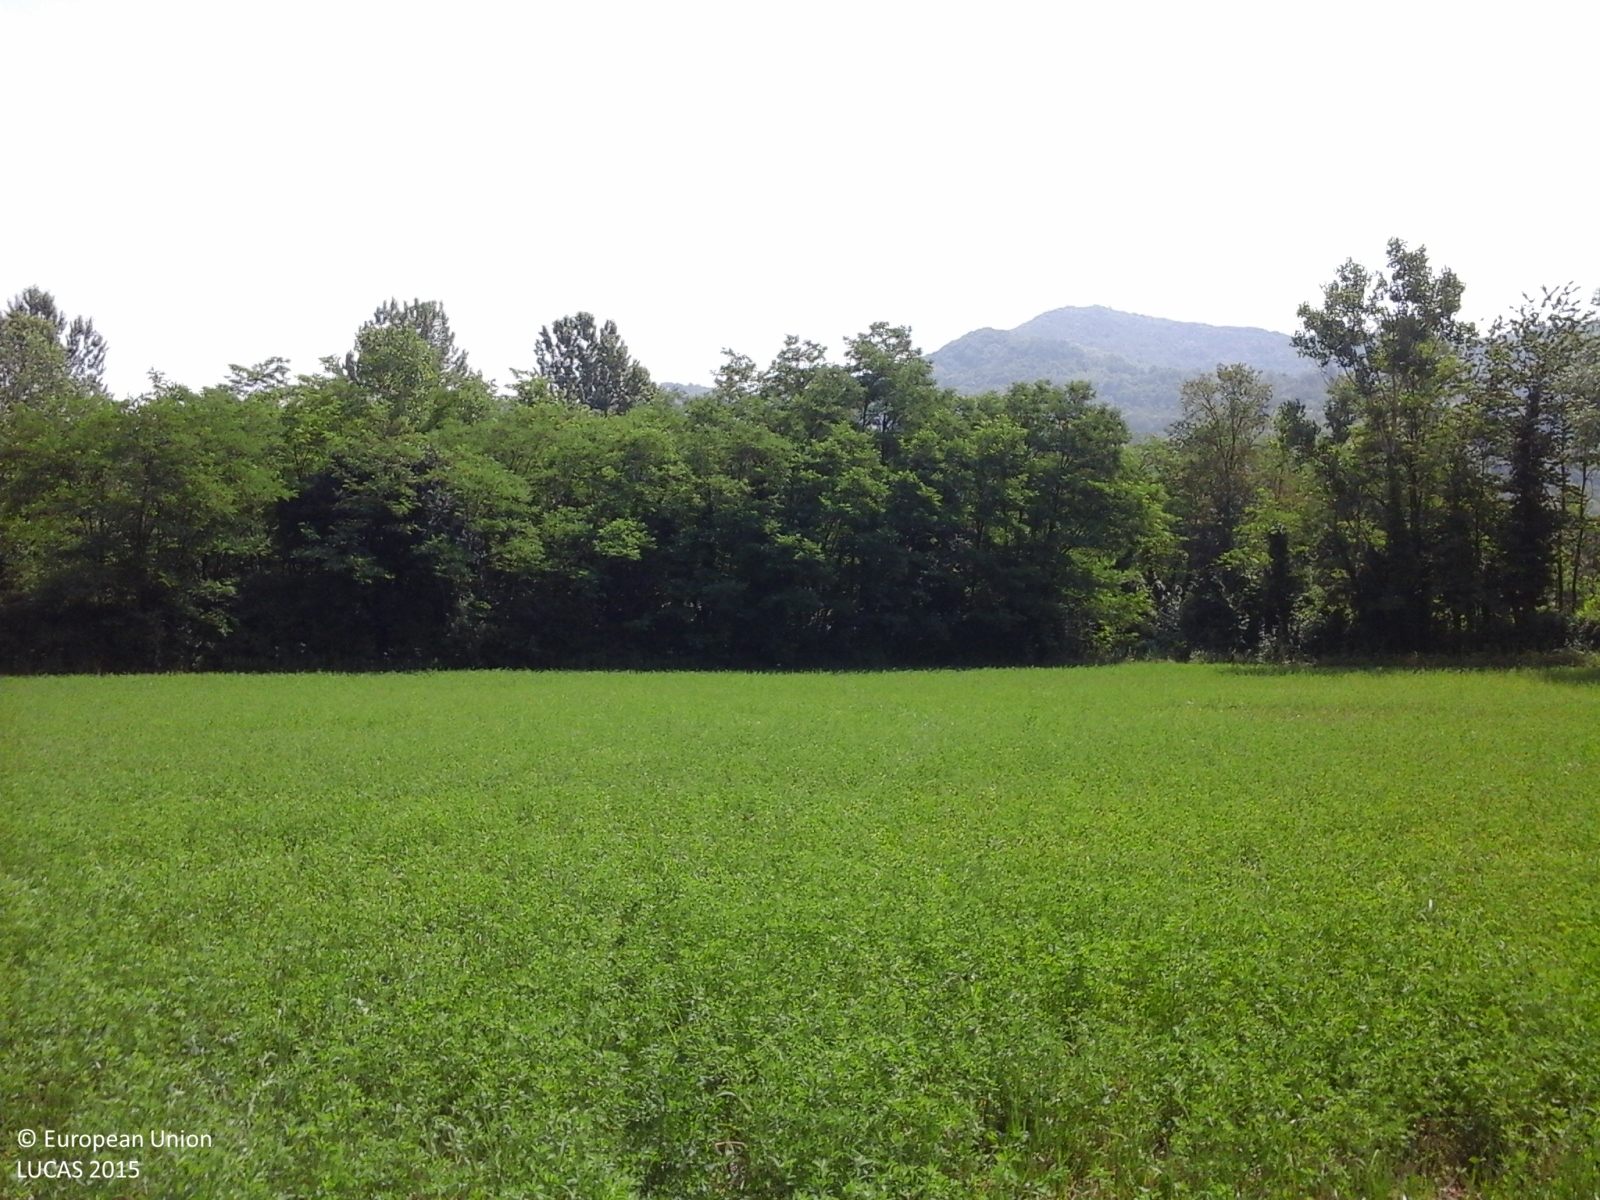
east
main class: Cropland
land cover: Lucerne
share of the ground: > 75 %
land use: Agriculture (excluding fallow land and kitchen gardens)
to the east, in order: Lucerne; Broadleaved woodland; Inland fresh running water
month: June
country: IT
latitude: 44.8367
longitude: 9.6087
